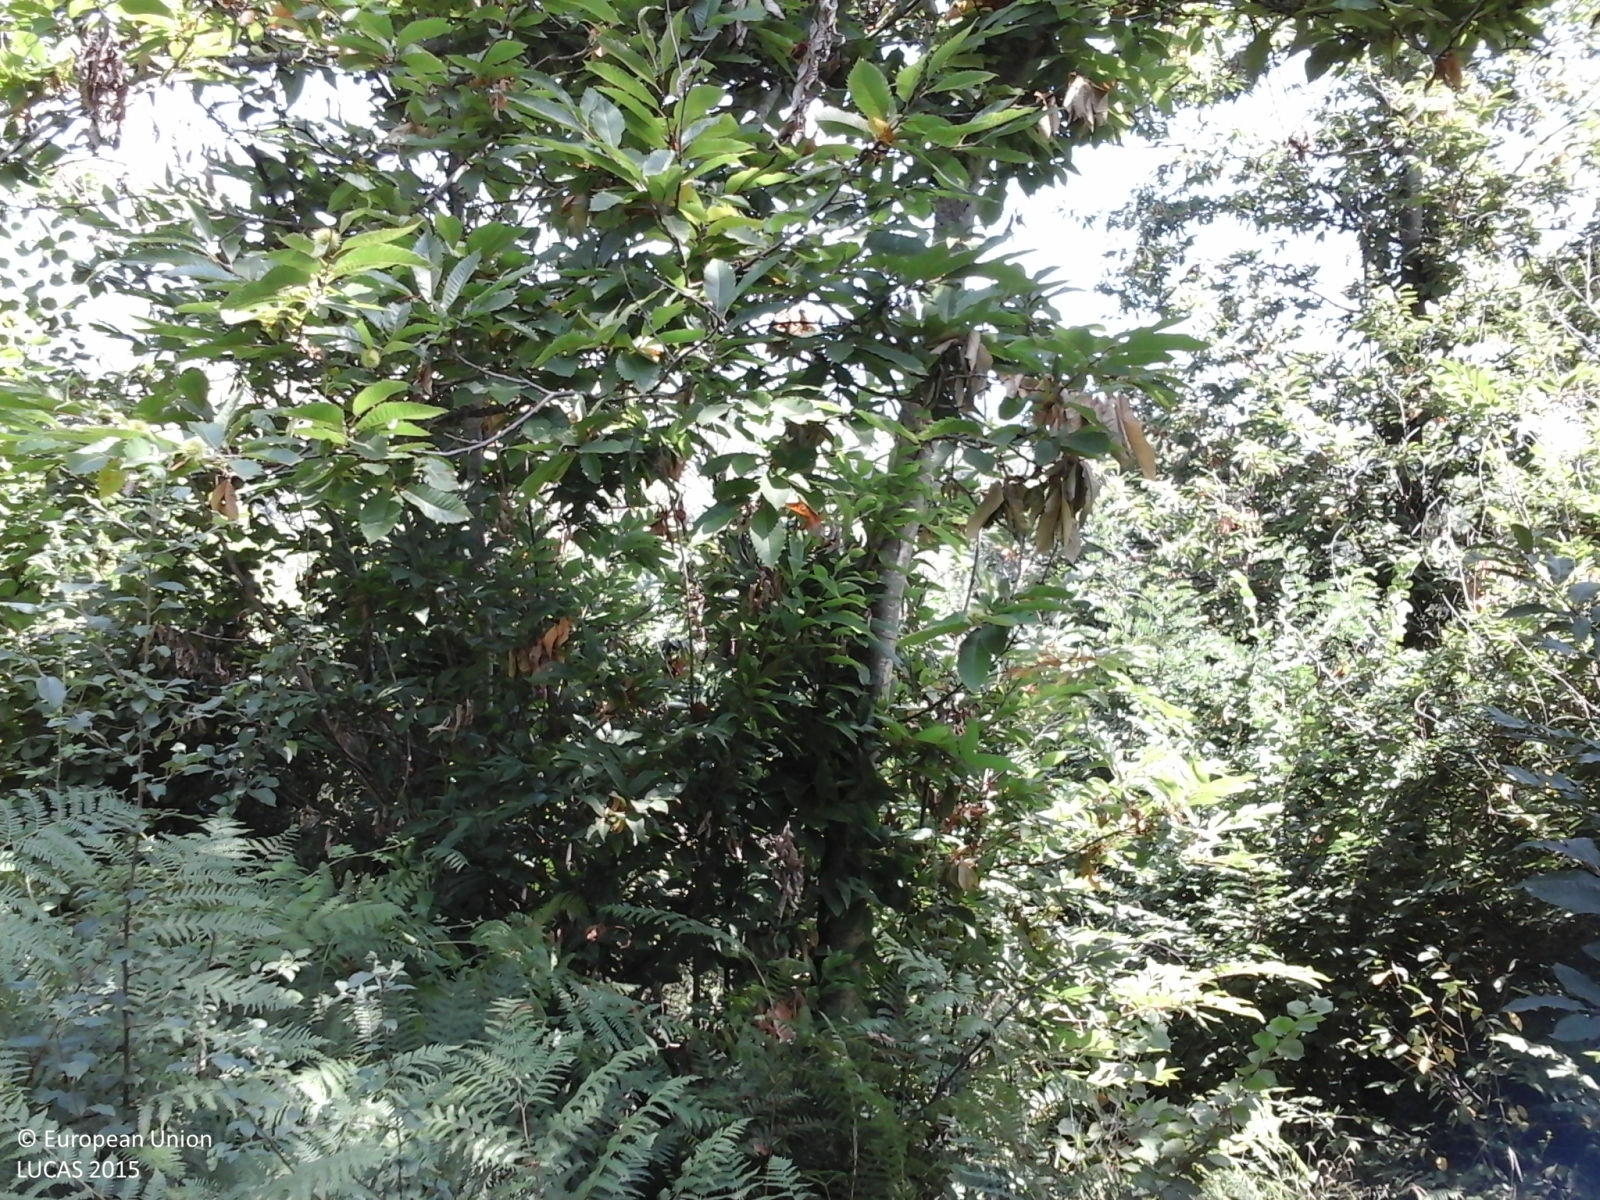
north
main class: Woodland
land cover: Broadleaved woodland
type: thermophilous deciduous forest
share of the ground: > 75 %
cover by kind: broadleaved forest trees 90 %, shrubs 5 %, herbaceous plants 5 %
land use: Semi-natural and natural areas not in use
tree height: > 5 m
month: July
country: IT
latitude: 41.5978
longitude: 12.9758
